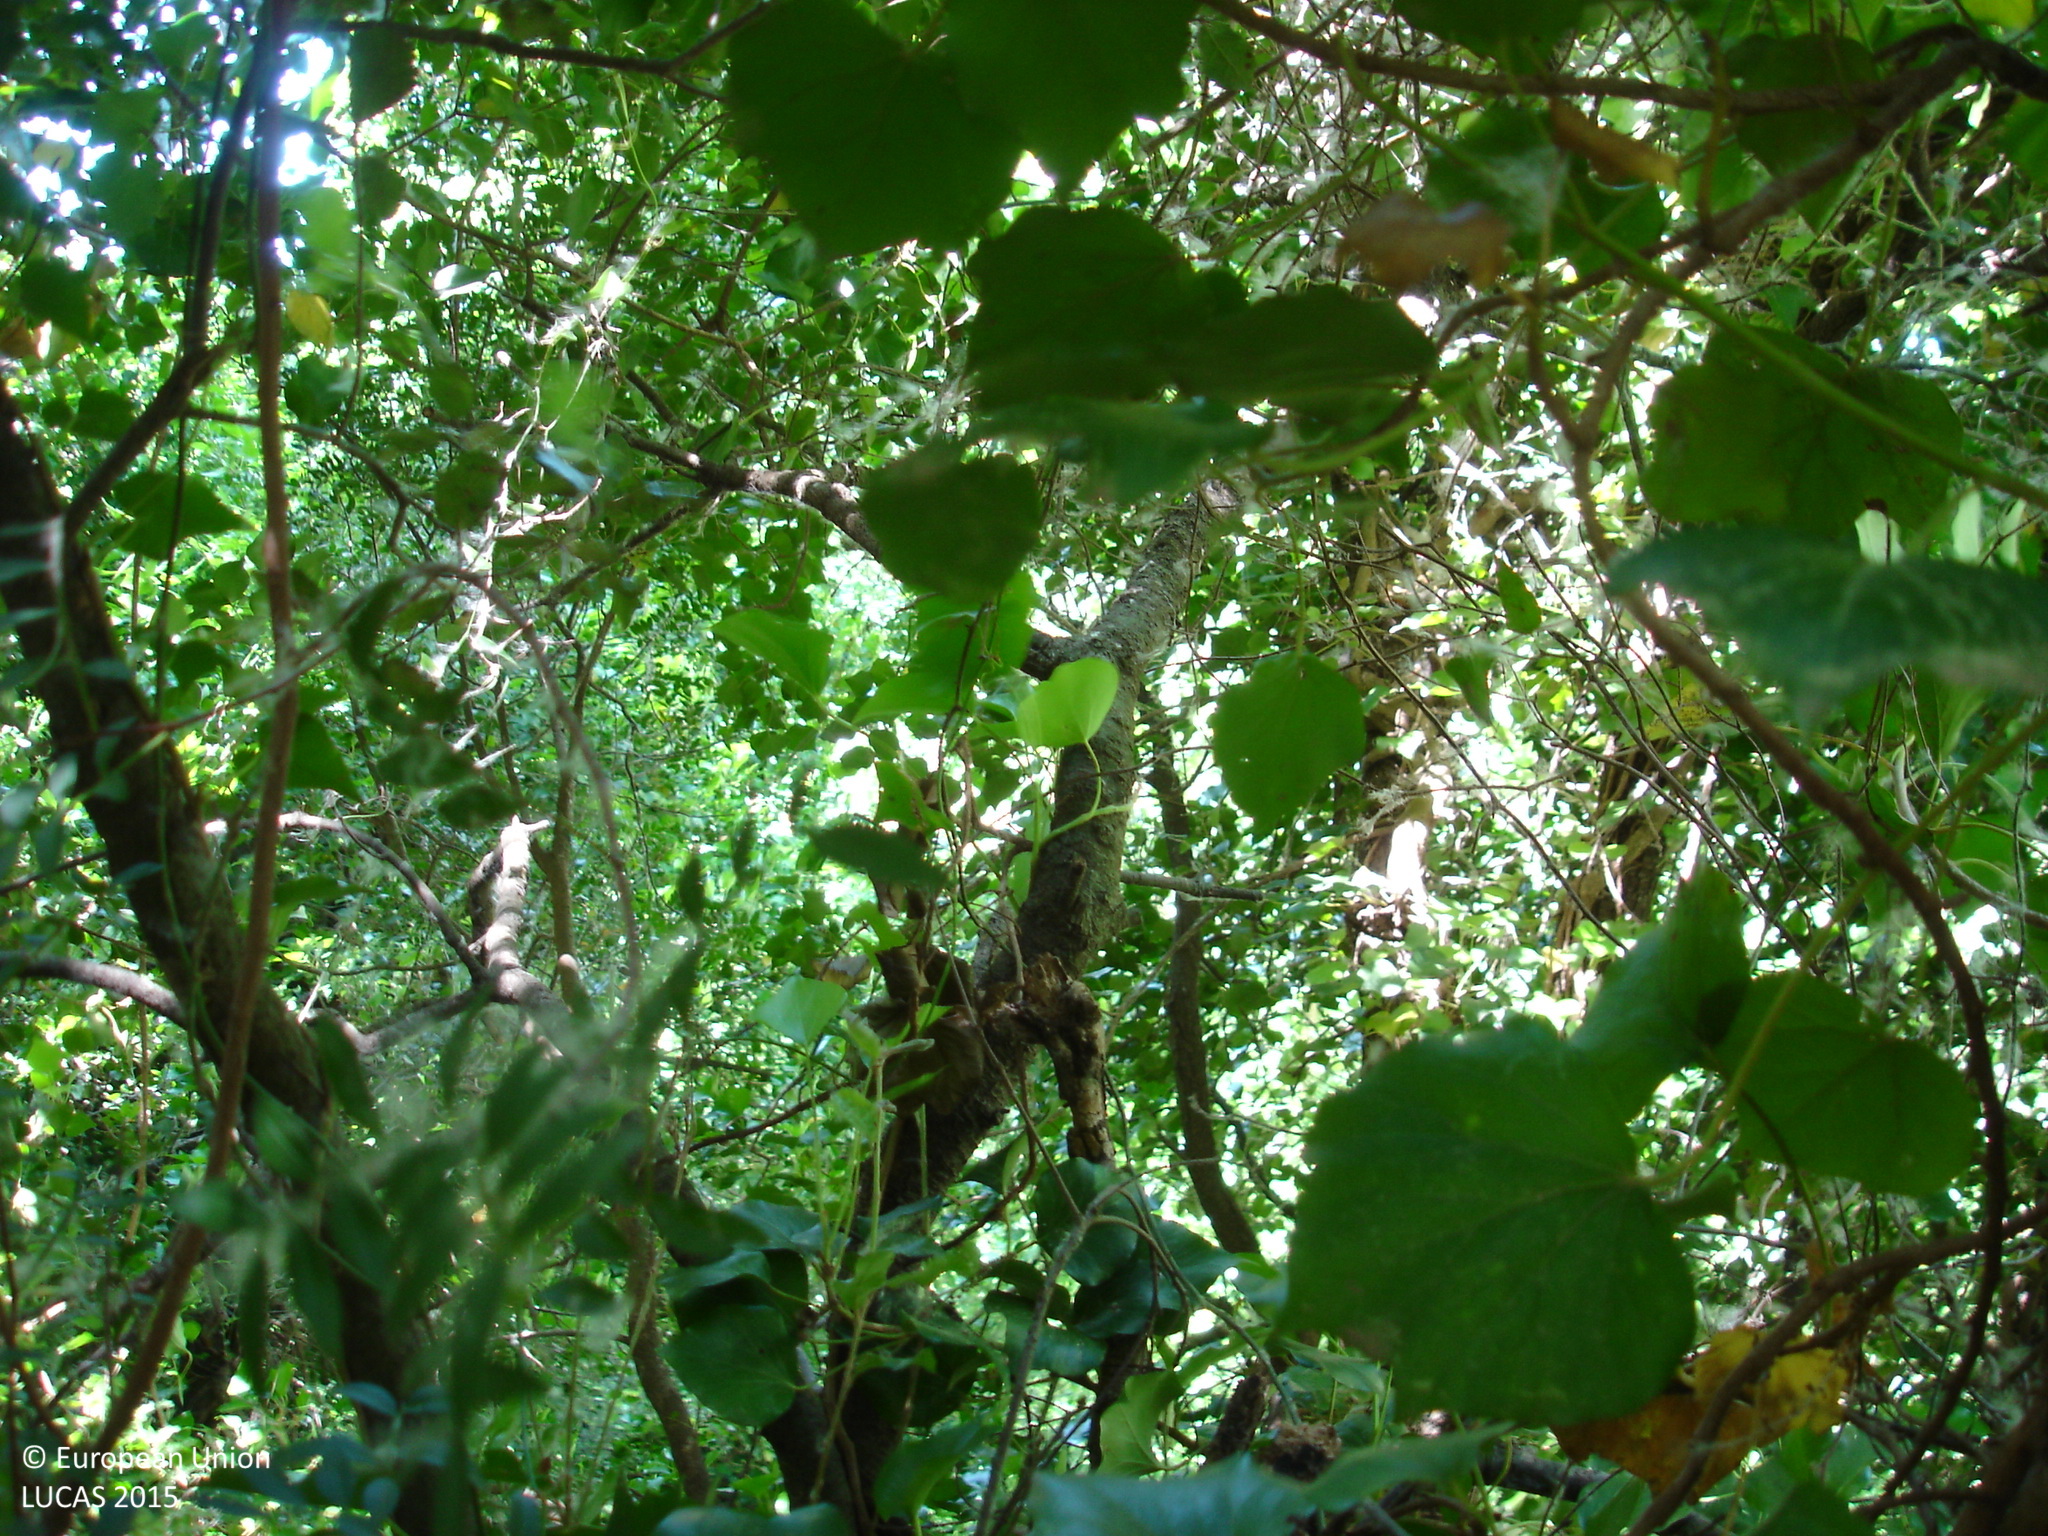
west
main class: Woodland
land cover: Broadleaved woodland
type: thermophilous deciduous forest
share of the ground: > 75 %
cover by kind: broadleaved forest trees 90 %, shrubs 10 %
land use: Forestry
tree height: > 5 m
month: May
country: ES
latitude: 42.1568
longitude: 2.9832
